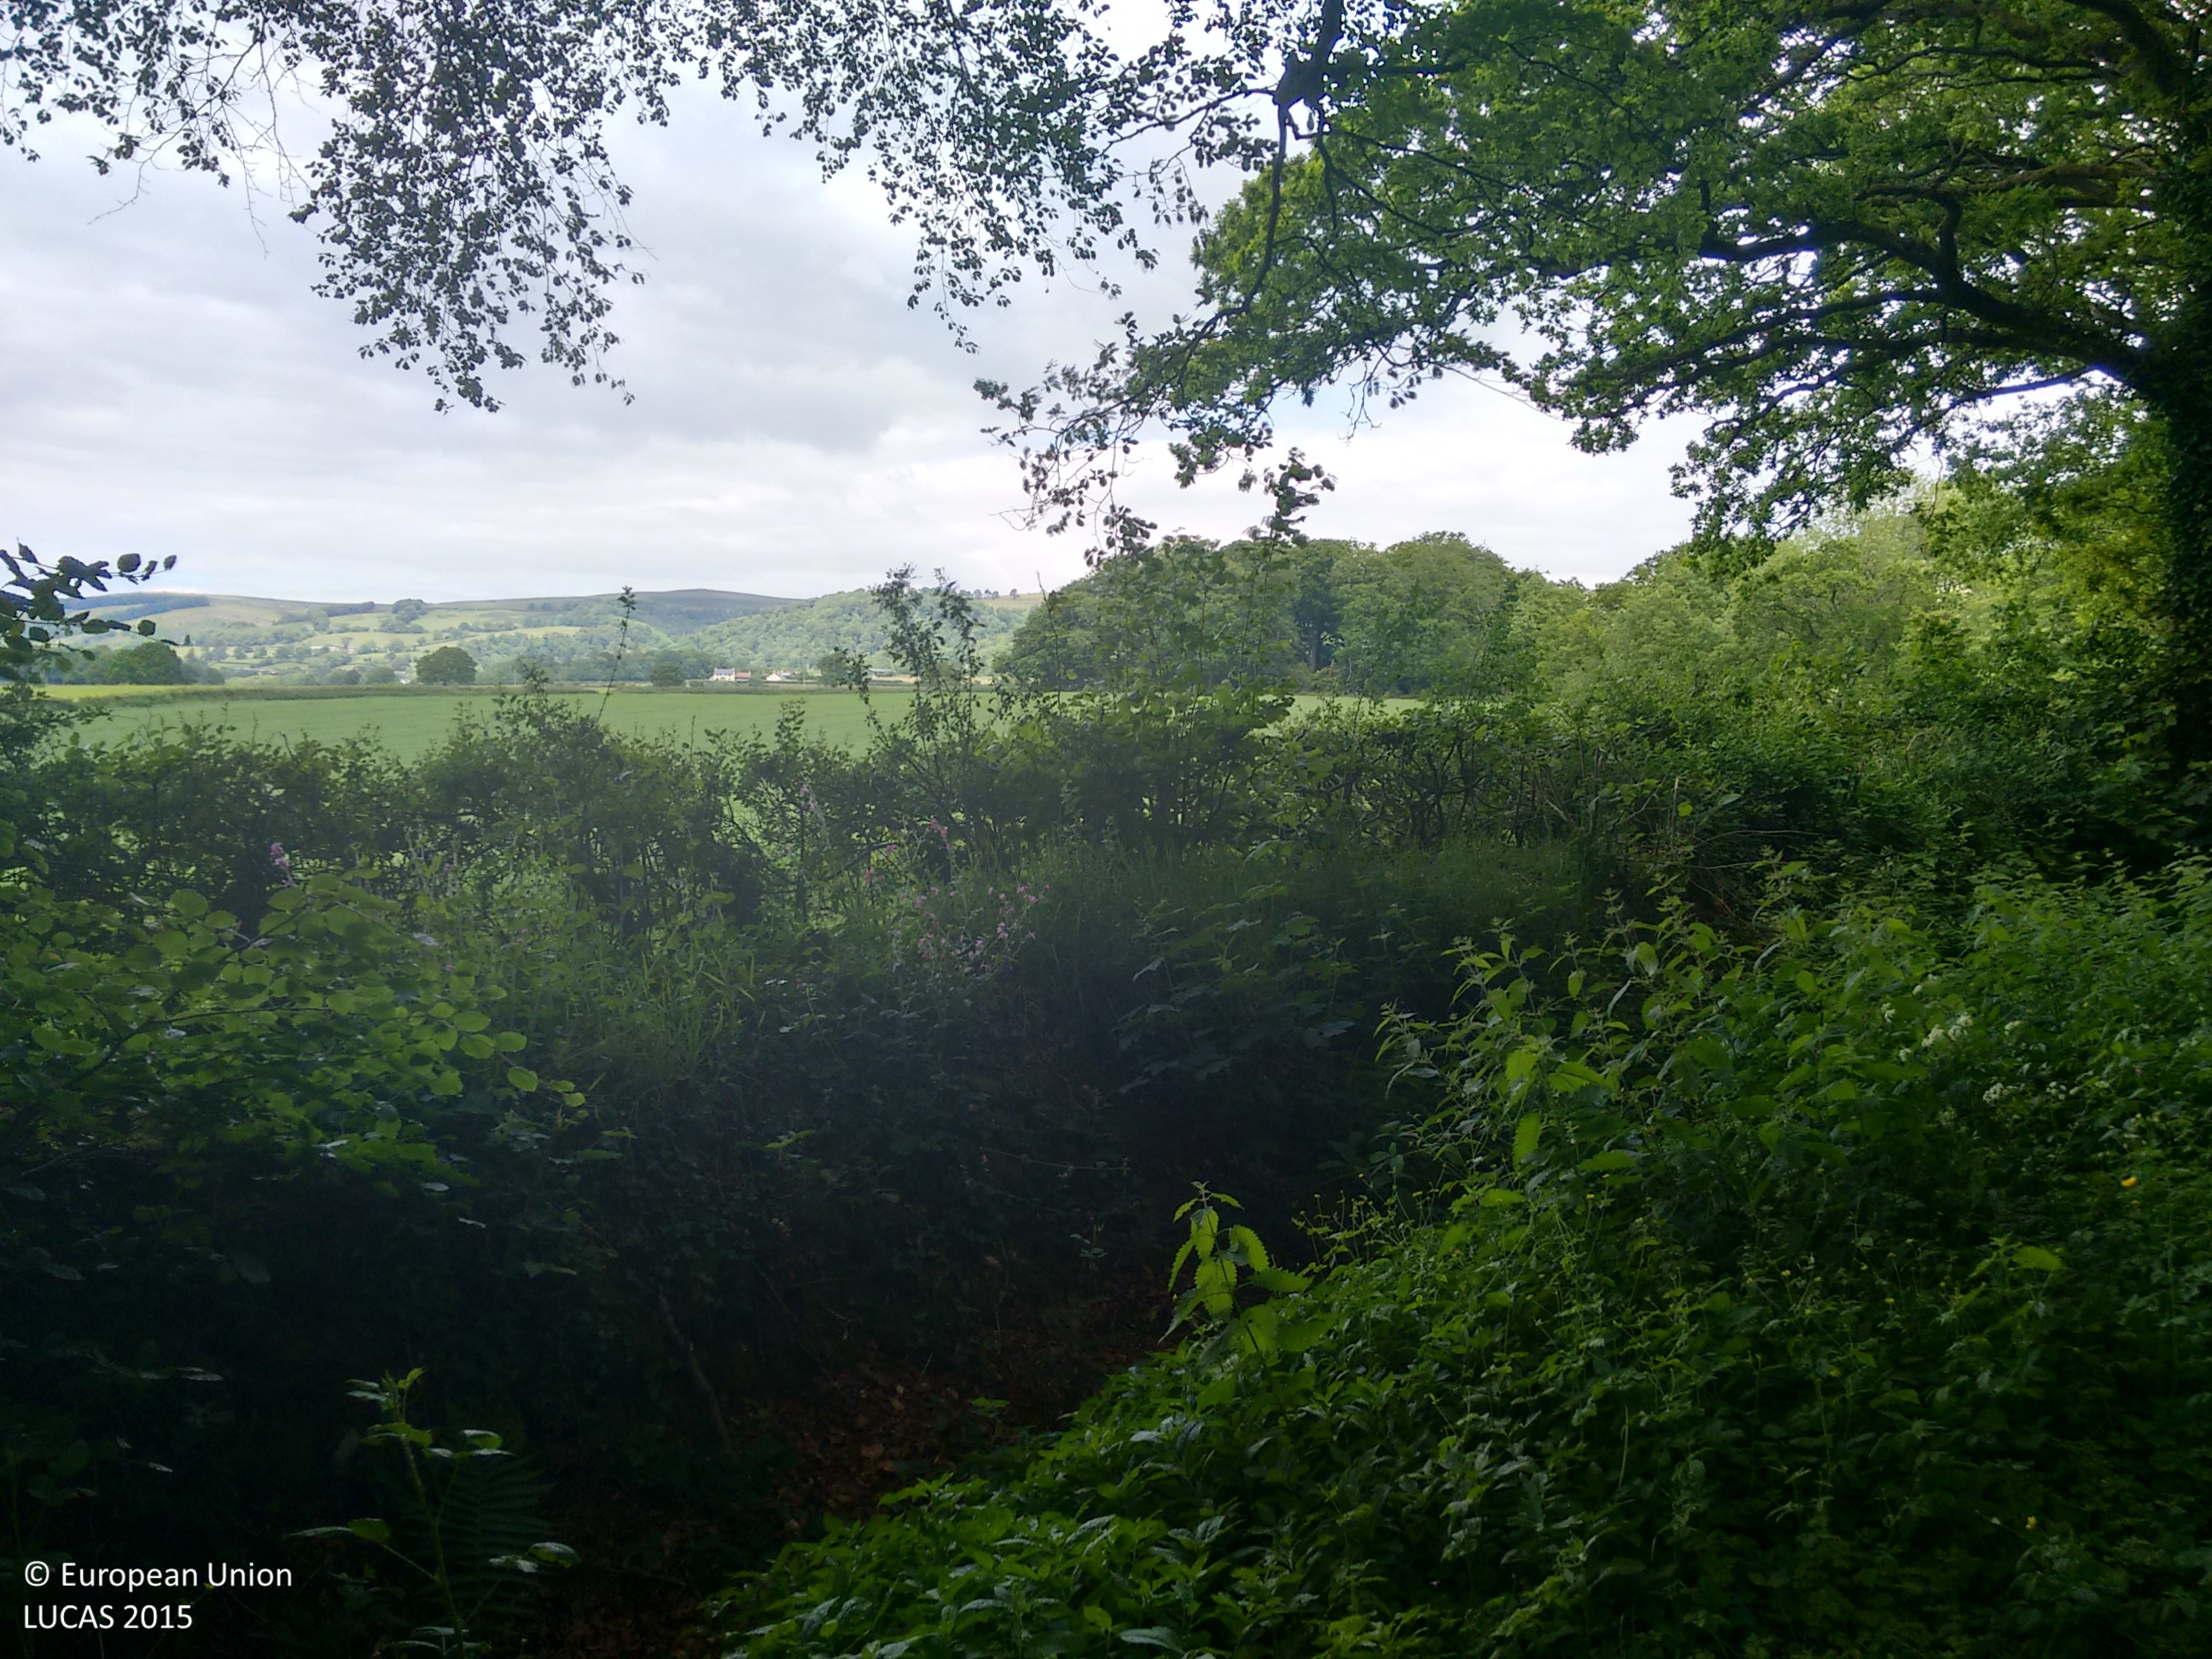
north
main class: Woodland
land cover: Broadleaved woodland
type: beech forest
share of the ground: > 75 %
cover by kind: broadleaved forest trees 90 %, herbaceous plants 10 %
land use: Semi-natural and natural areas not in use
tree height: > 5 m
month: June
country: GB
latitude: 51.1038
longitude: -3.2326
